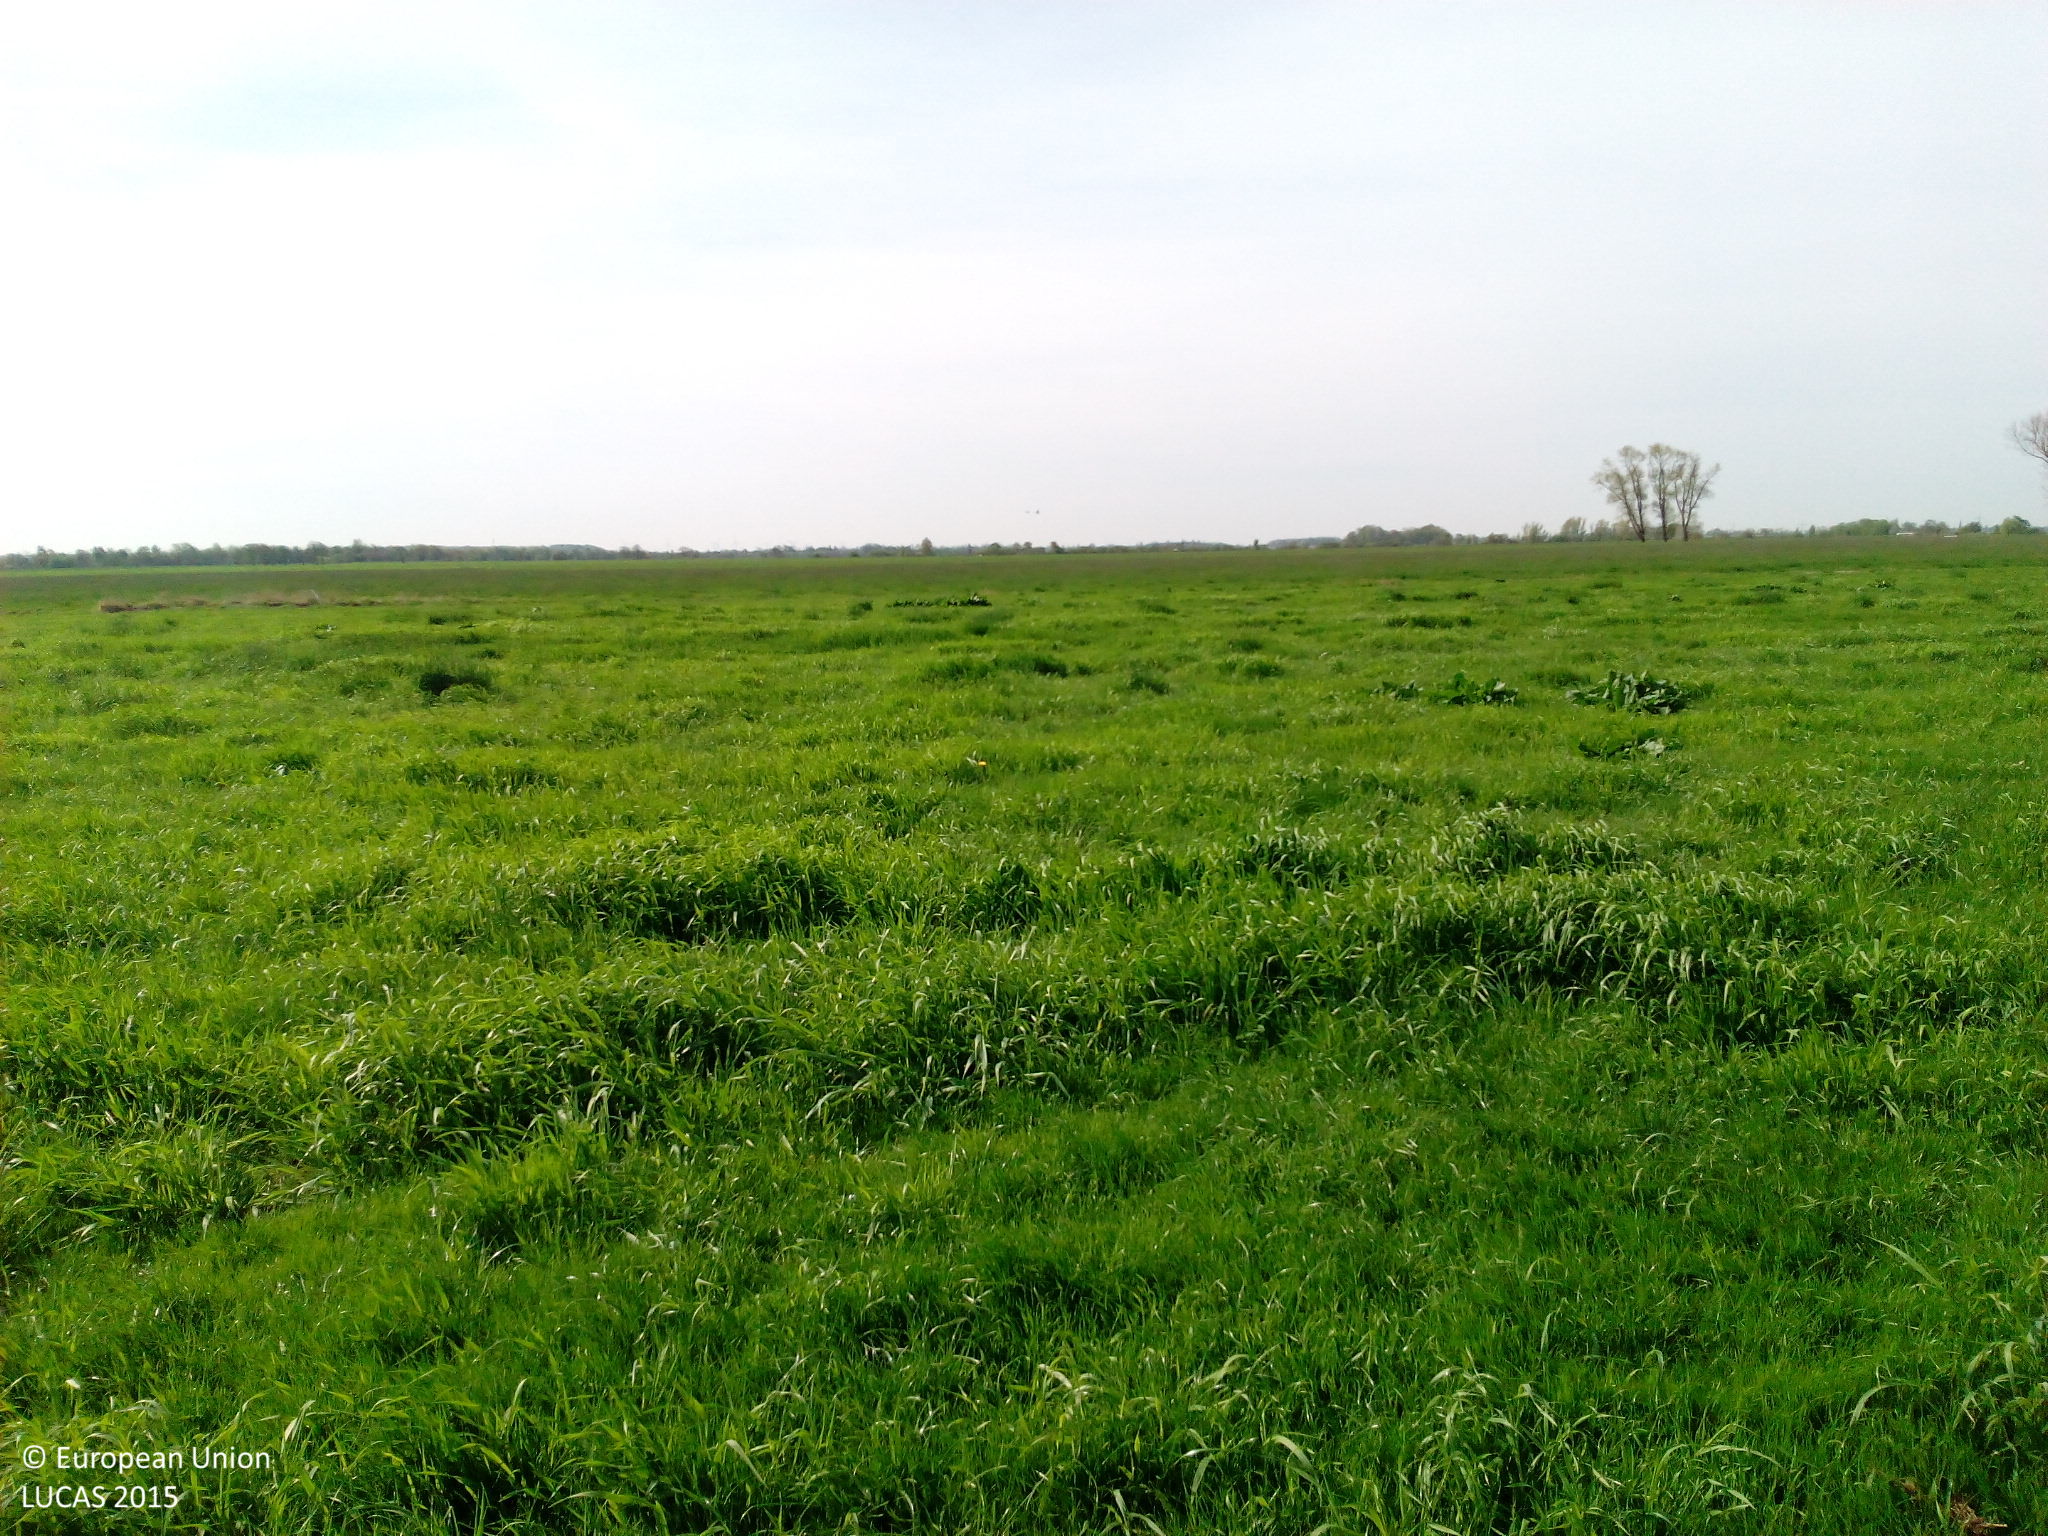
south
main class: Grassland
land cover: Grassland without tree/shrub cover
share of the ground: > 75 %
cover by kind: herbaceous plants 100 %
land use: Agriculture (excluding fallow land and kitchen gardens)
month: May
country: DE
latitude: 53.4115
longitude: 8.5714
